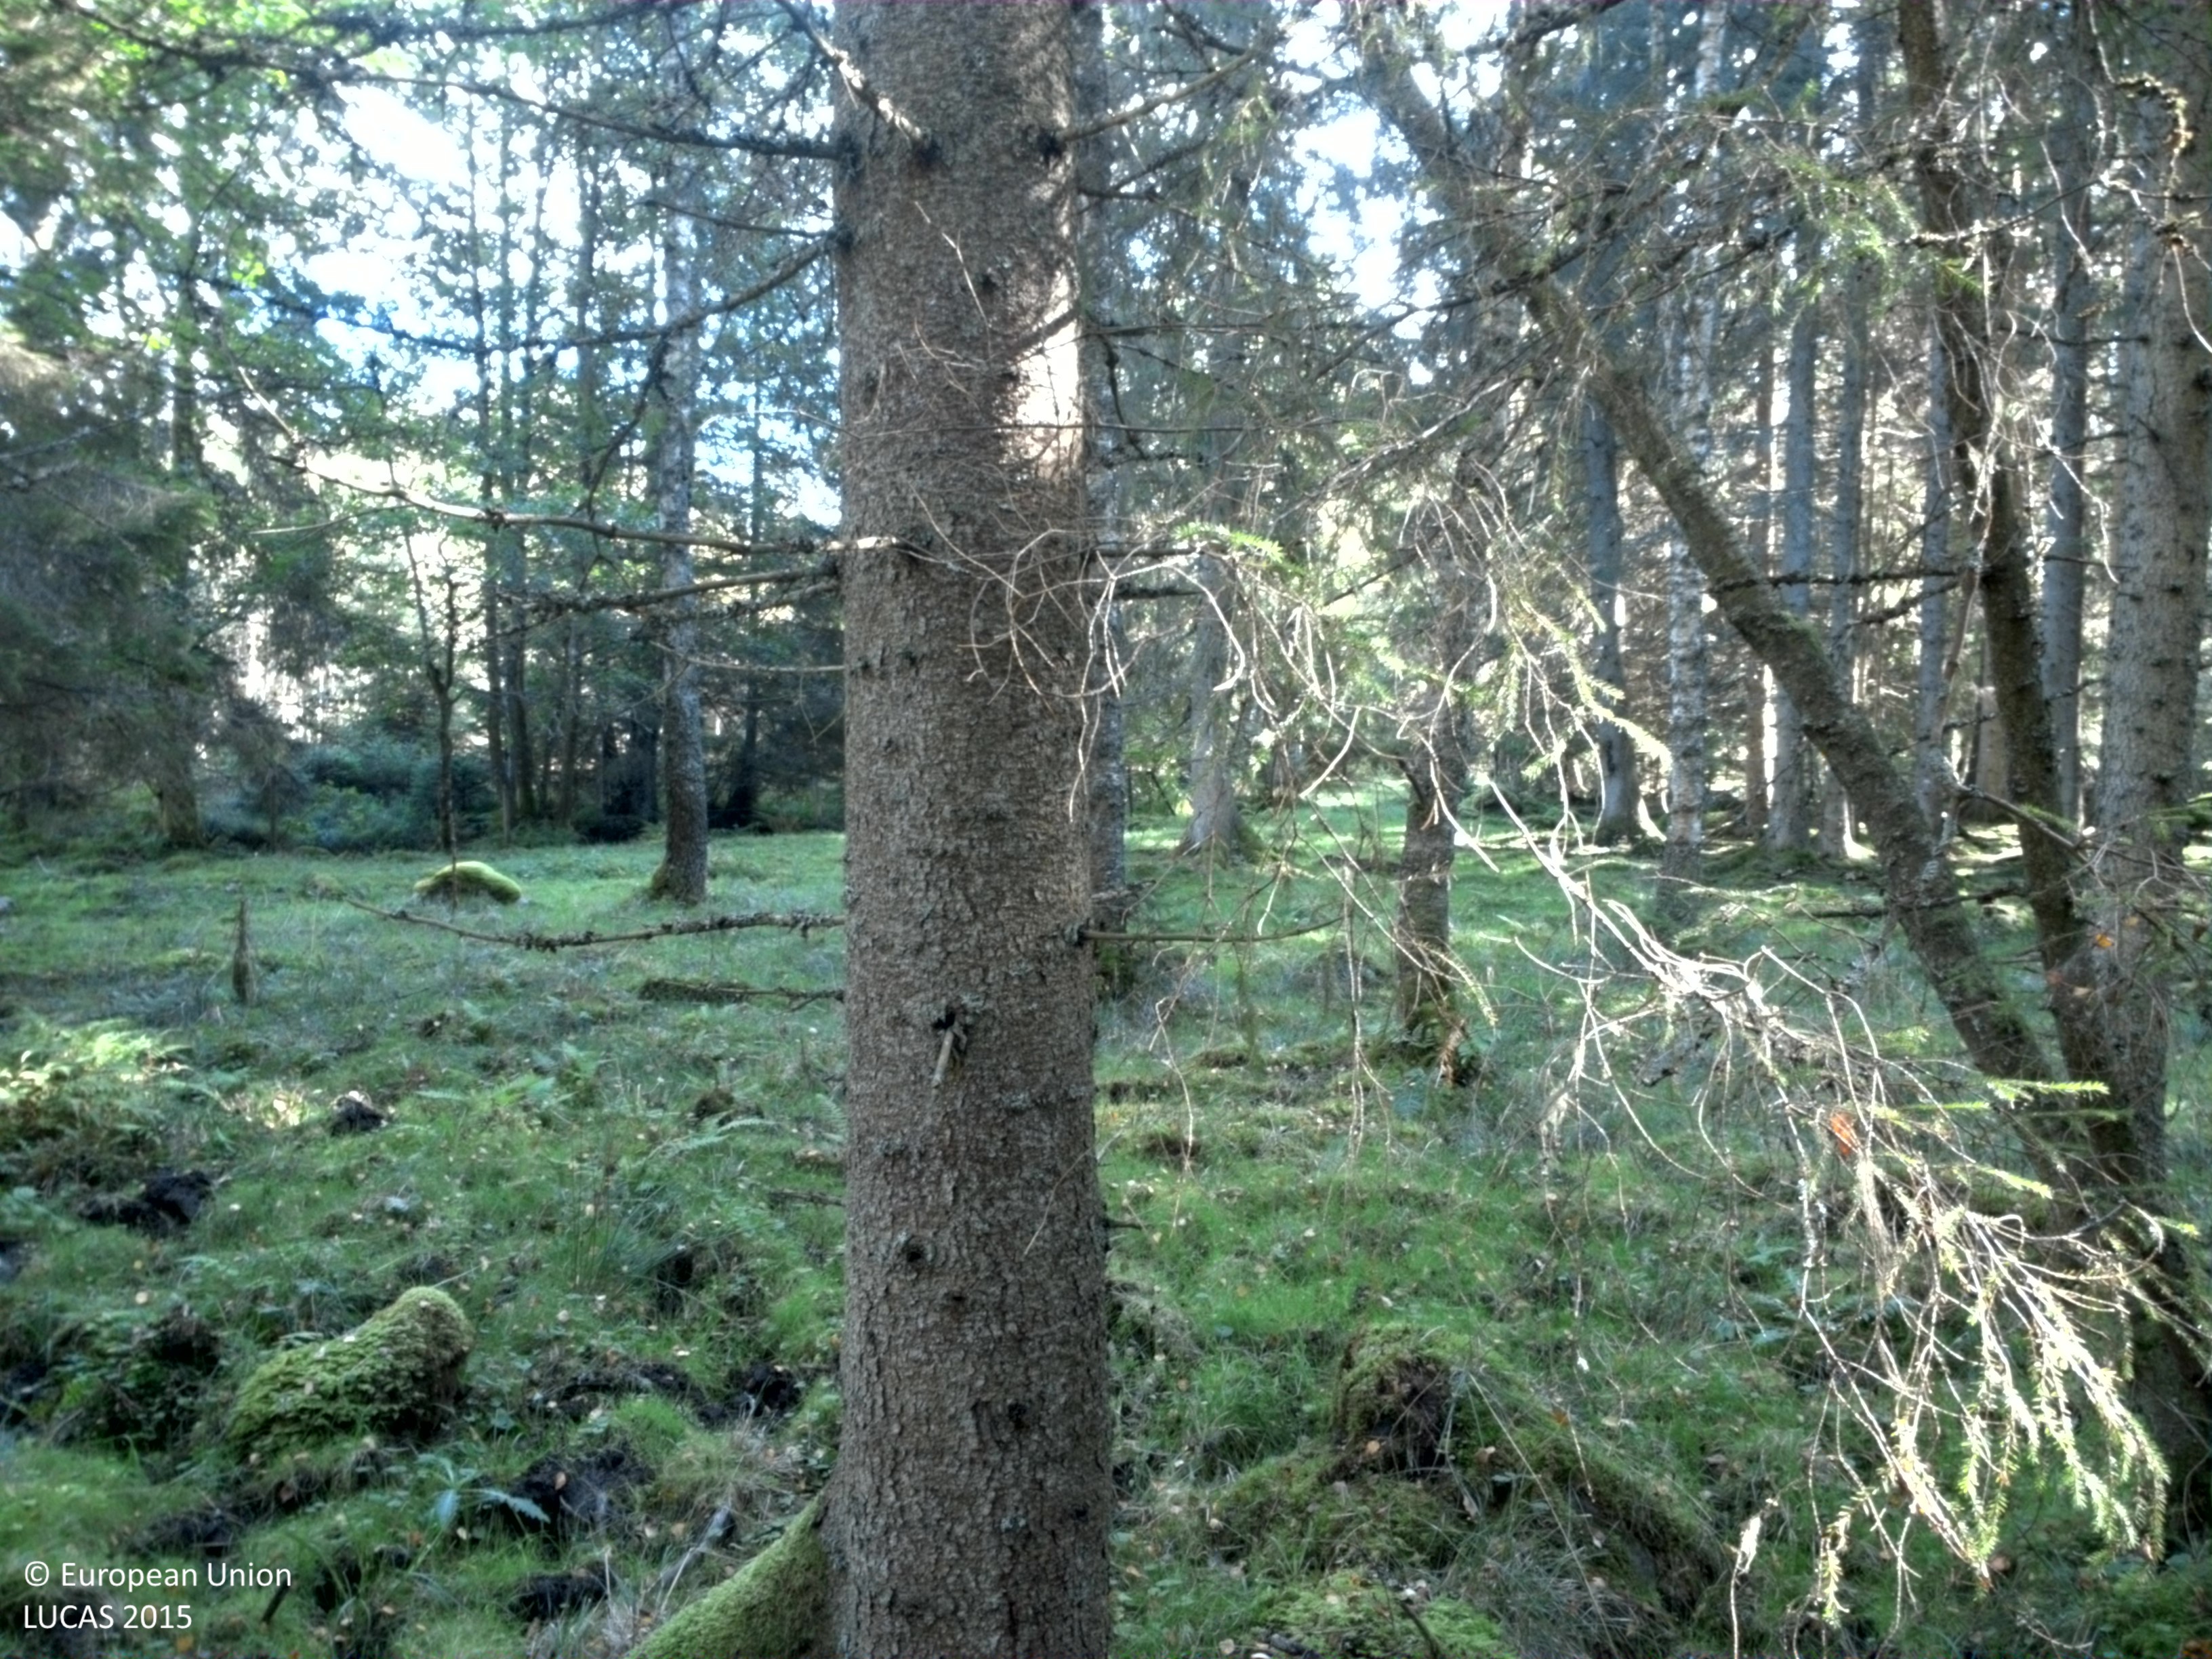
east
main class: Woodland
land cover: Spruce dominated mixed woodland
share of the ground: 50 - 75 %
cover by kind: coniferous forest trees 40 %, lichens and mosses 30 %, broadleaved forest trees 25 %, herbaceous plants 5 %
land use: Forestry
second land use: Agriculture (excluding fallow land and kitchen gardens)
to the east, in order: Spruce dominated mixed woodland; Grassland with sparse tree/shrub cover; Fences; Inland fresh running water; Spruce dominated mixed woodland; Tracks; Grassland with sparse tree/shrub cover; Spruce dominated mixed woodland
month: September
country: SE
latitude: 57.9461
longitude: 13.2555
